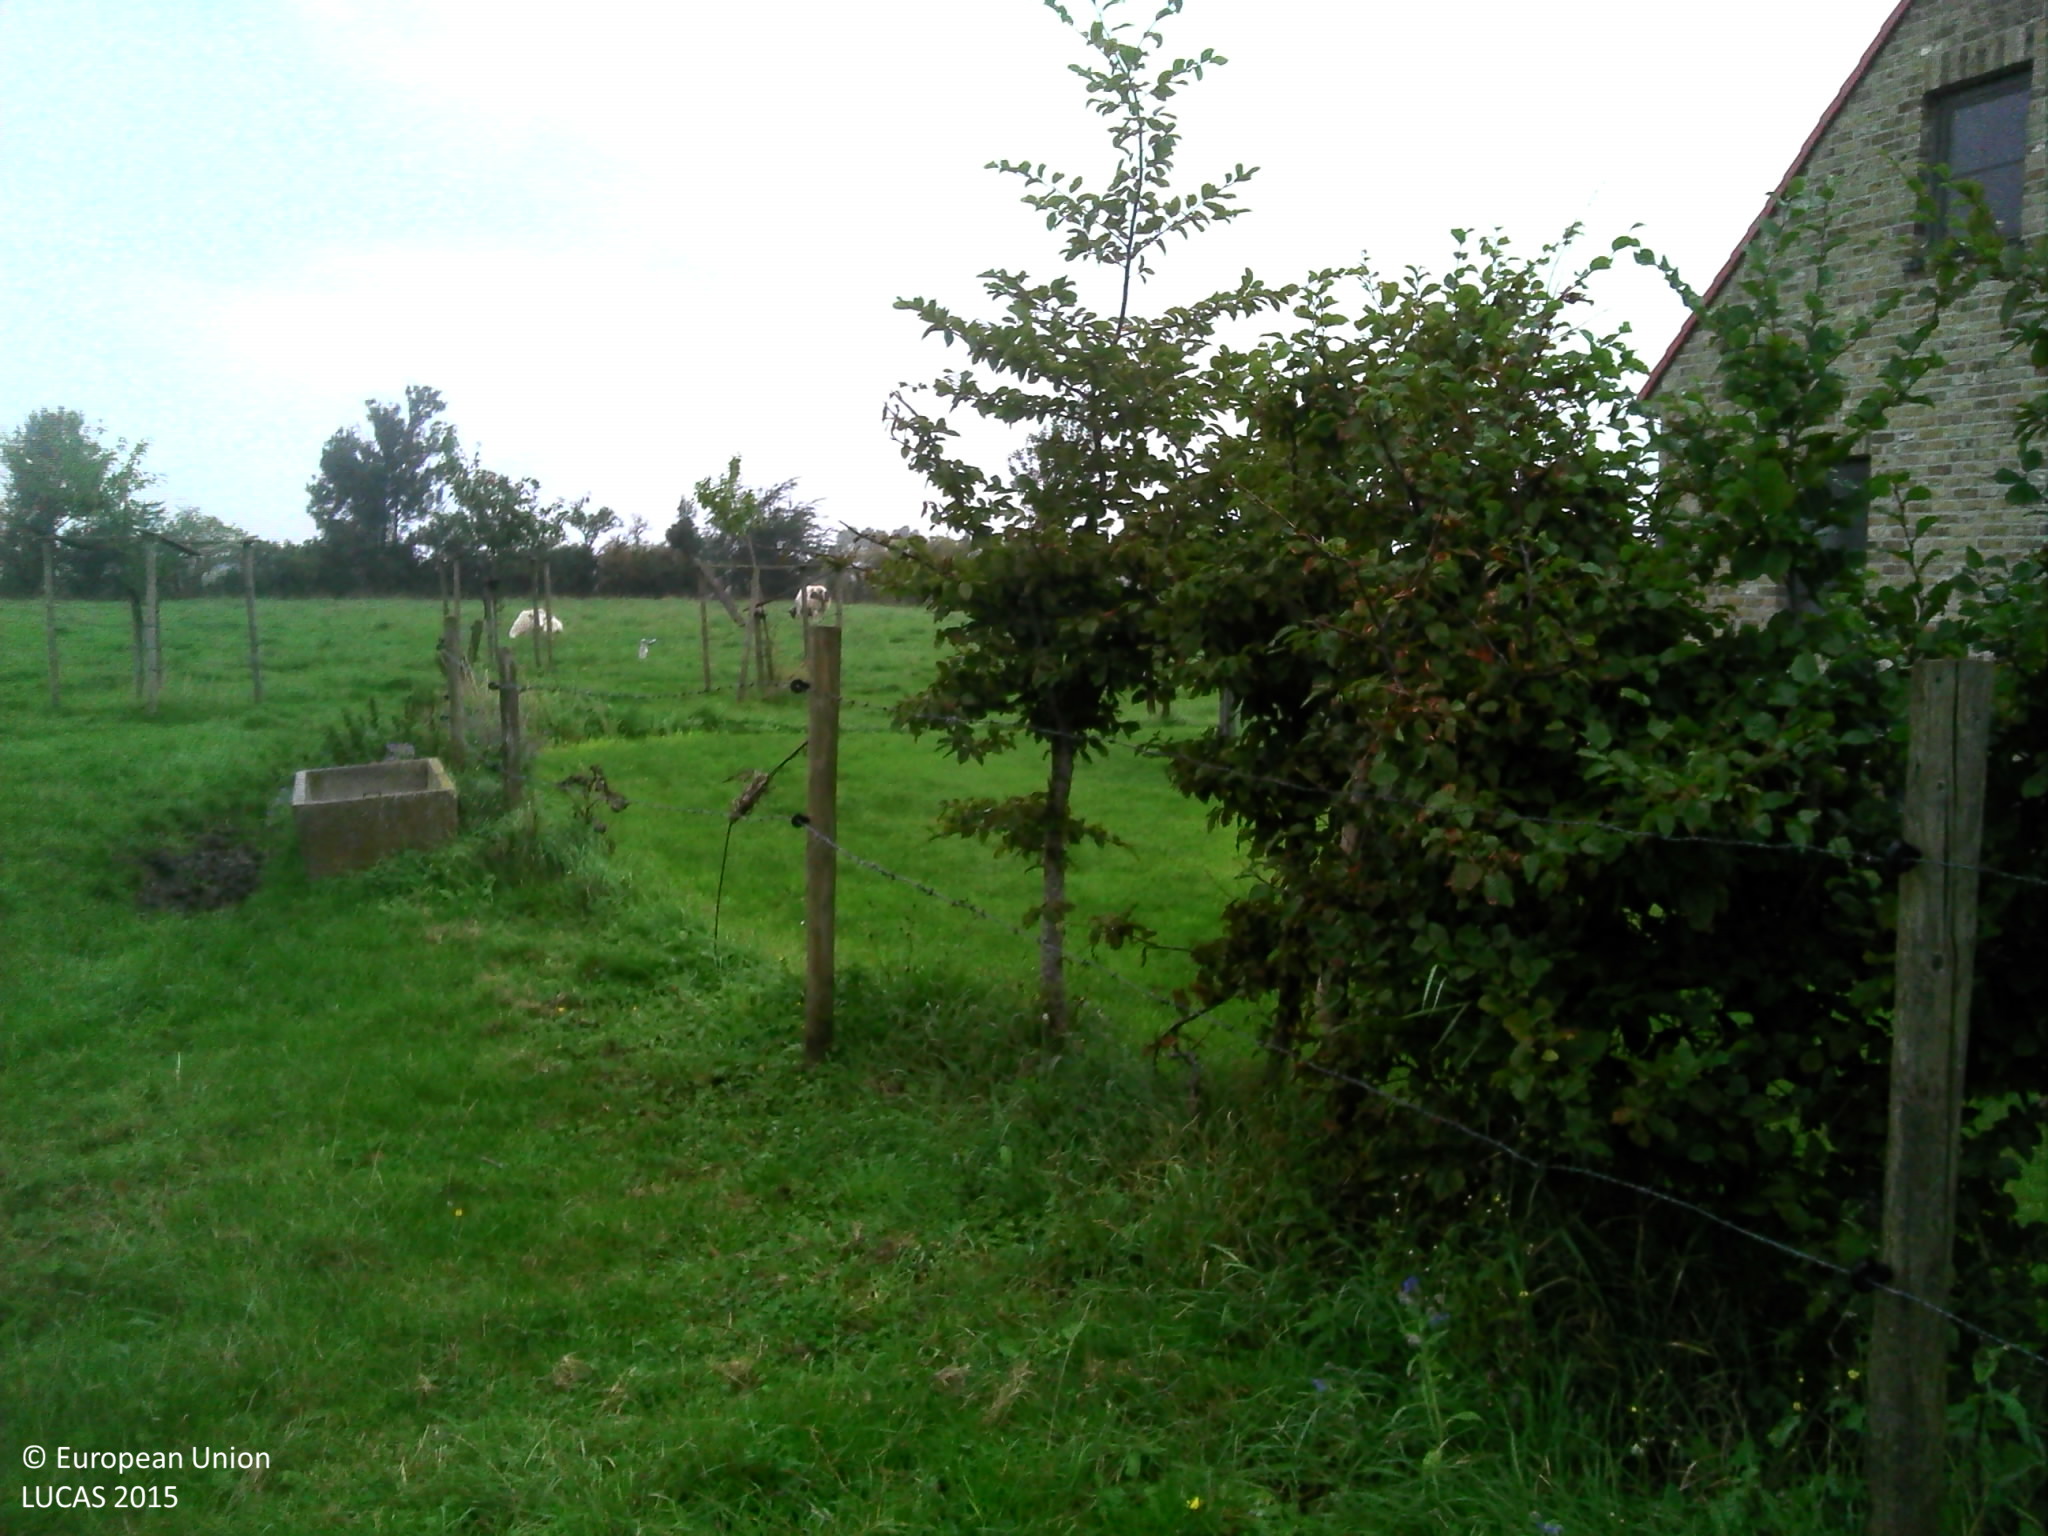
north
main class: Grassland
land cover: Grassland without tree/shrub cover
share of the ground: > 75 %
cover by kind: herbaceous plants 100 %
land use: Agriculture (excluding fallow land and kitchen gardens)
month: September
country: BE
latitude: 51.0532
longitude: 2.7270
